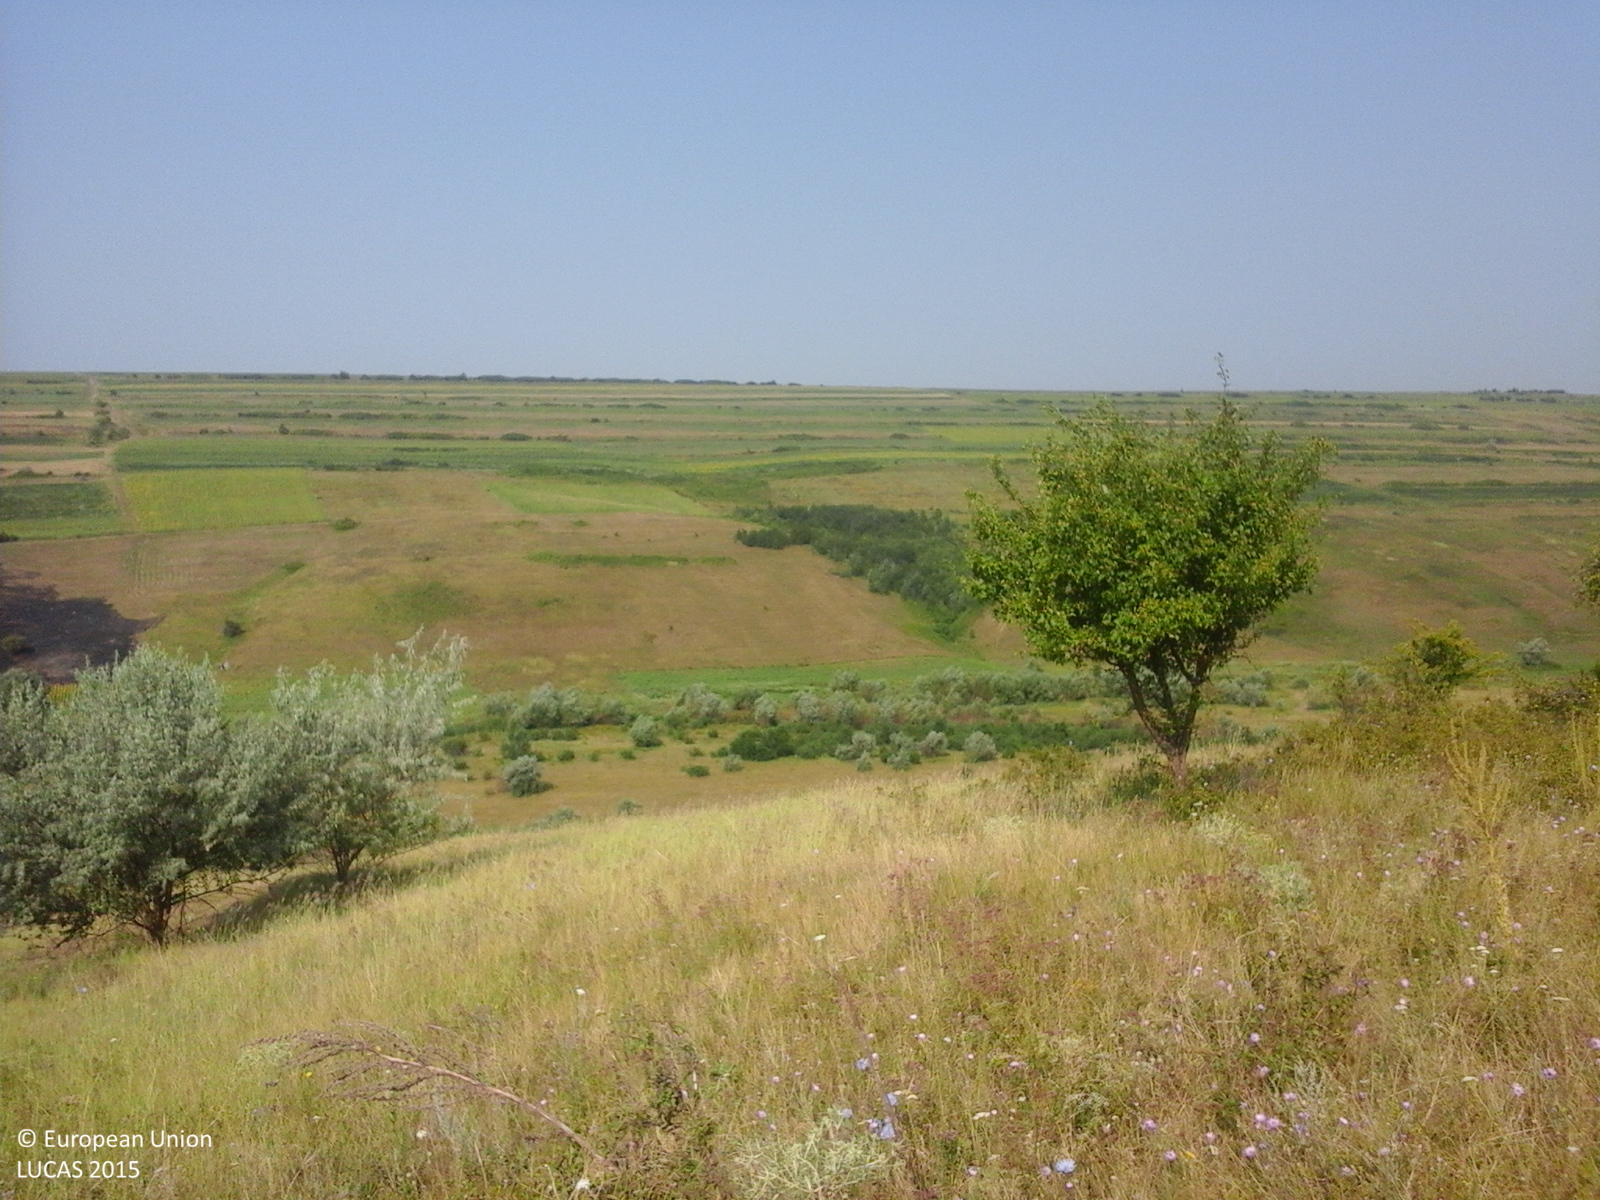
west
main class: Grassland
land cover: Grassland with sparse tree/shrub cover
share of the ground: > 75 %
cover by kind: herbaceous plants 95 %, broadleaved forest trees 5 %
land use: Agriculture (excluding fallow land and kitchen gardens)
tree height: > 5 m
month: July
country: RO
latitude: 46.4740
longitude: 27.6319
